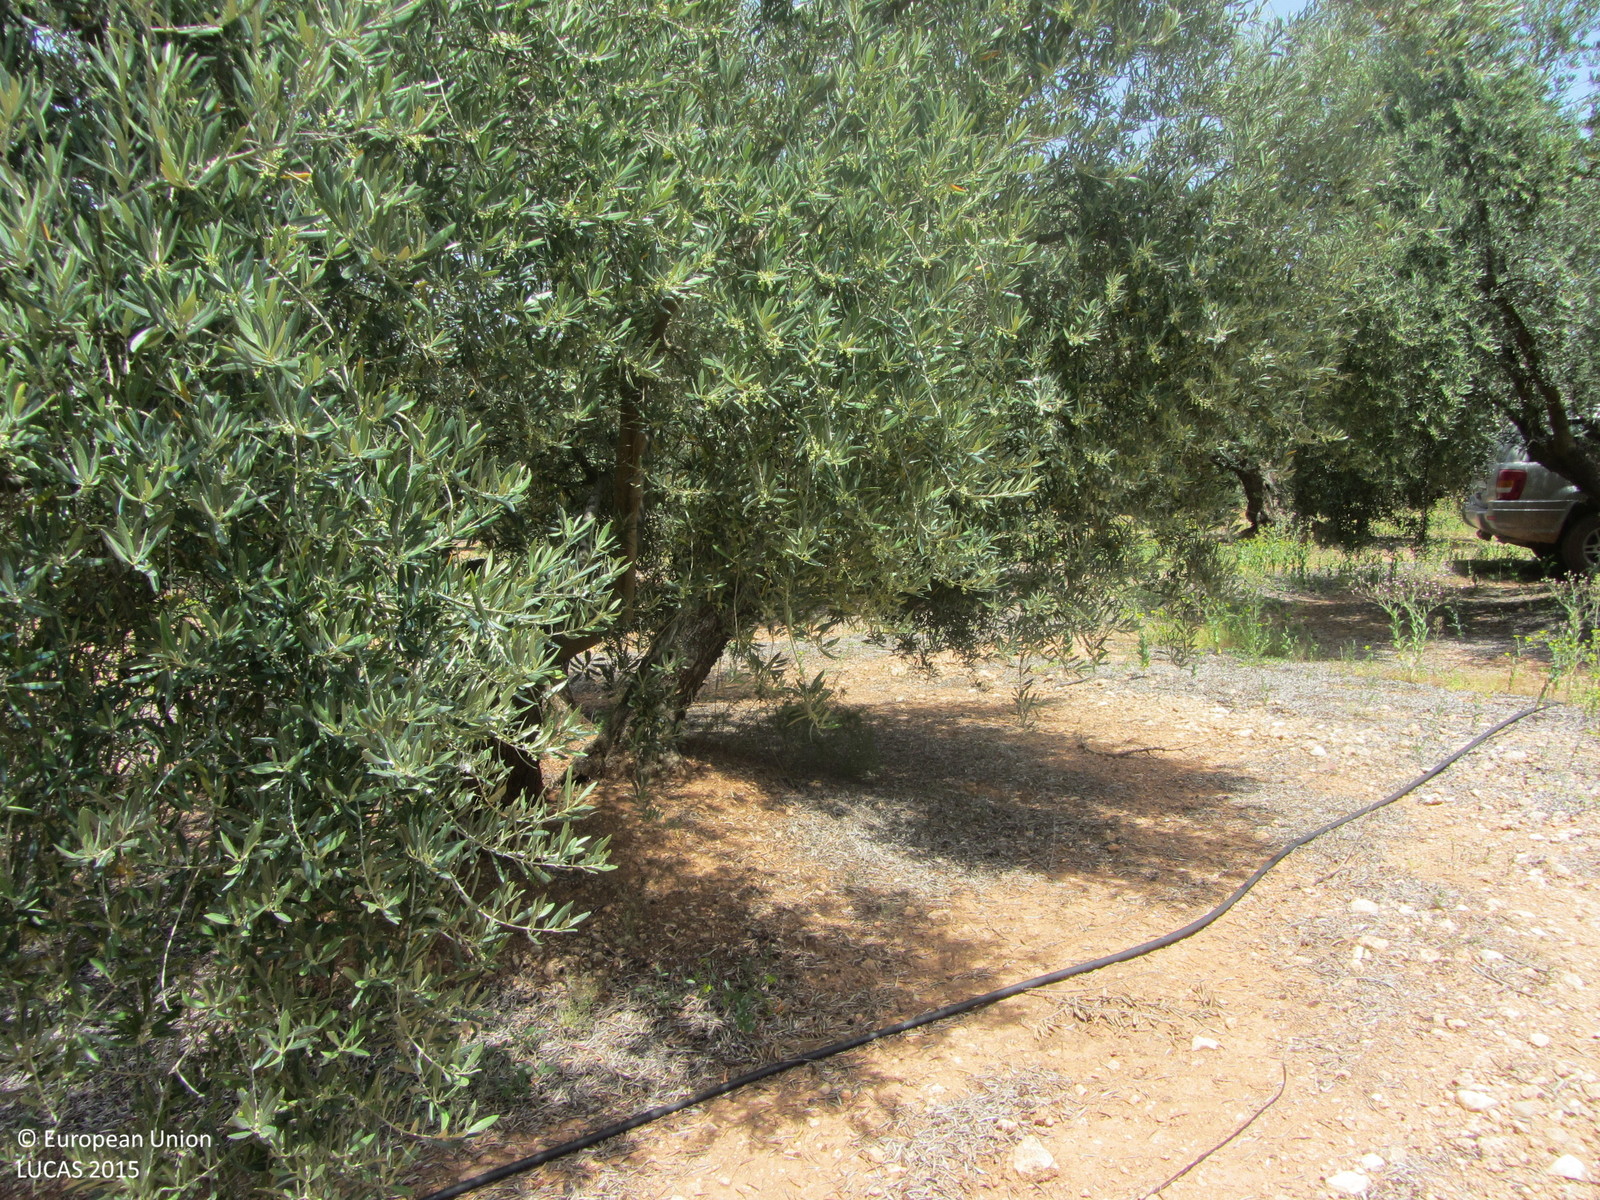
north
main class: Cropland
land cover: Olive groves
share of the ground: 25 - 50 %
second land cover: Spontaneously vegetated surfaces
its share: 10 - 25 %
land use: Agriculture (excluding fallow land and kitchen gardens)
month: May
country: ES
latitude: 38.2876
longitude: -2.9534
